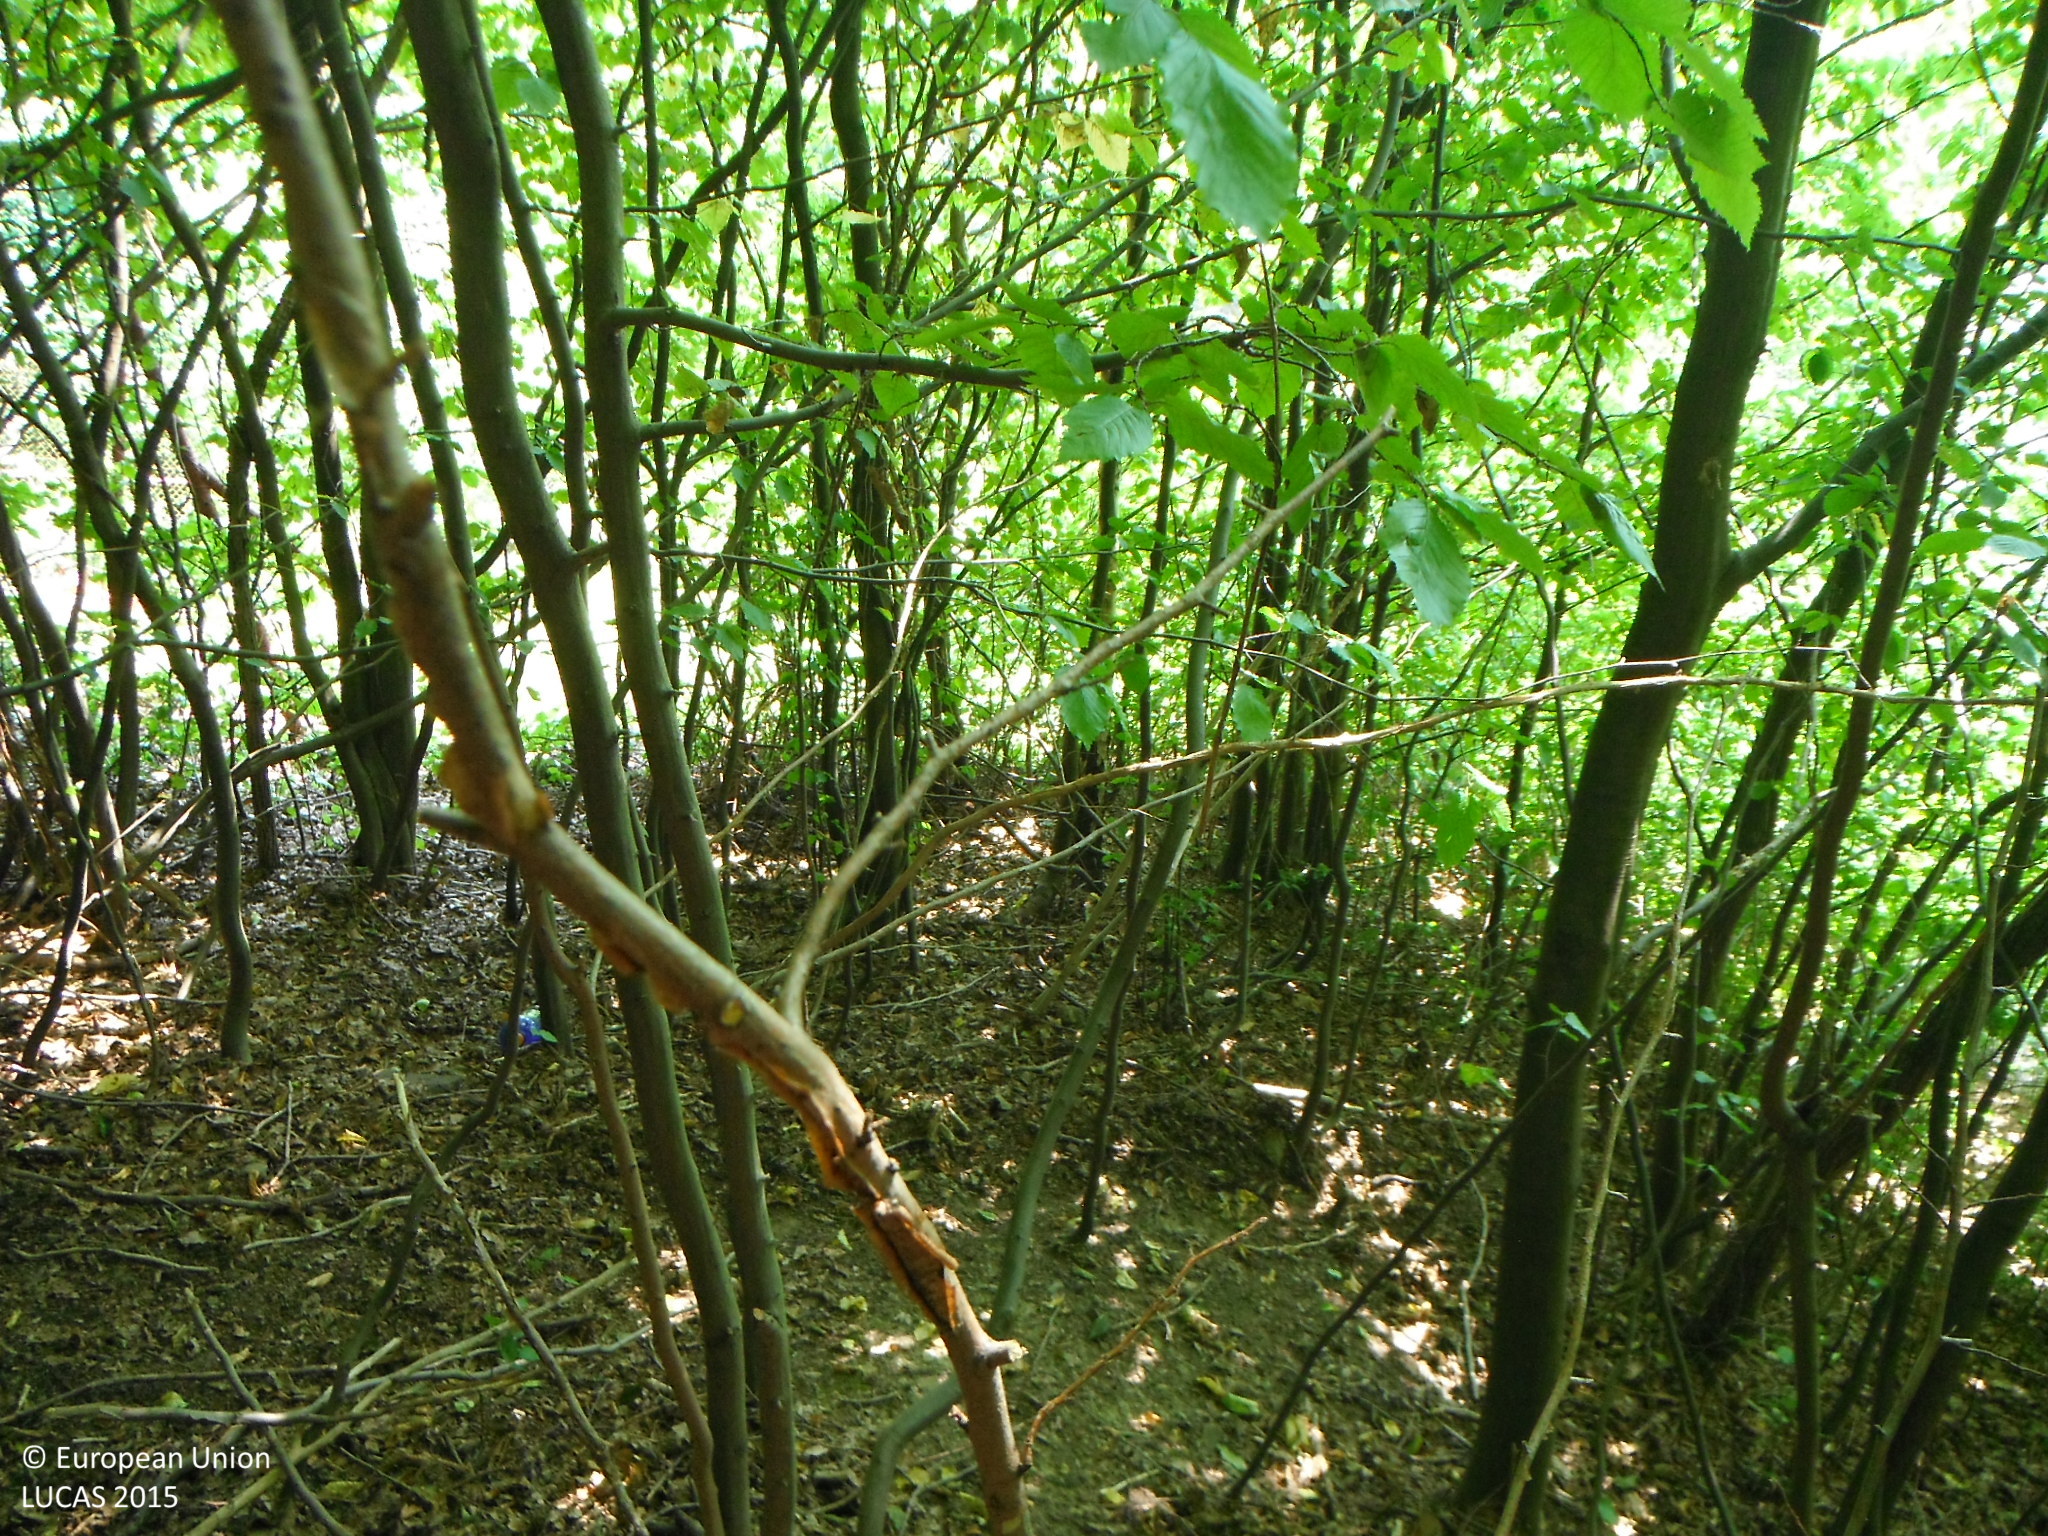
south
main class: Woodland
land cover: Broadleaved woodland
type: beech forest
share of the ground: > 75 %
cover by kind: broadleaved forest trees 100 %
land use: Forestry
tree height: > 5 m
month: August
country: SK
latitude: 49.3001
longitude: 18.8080
